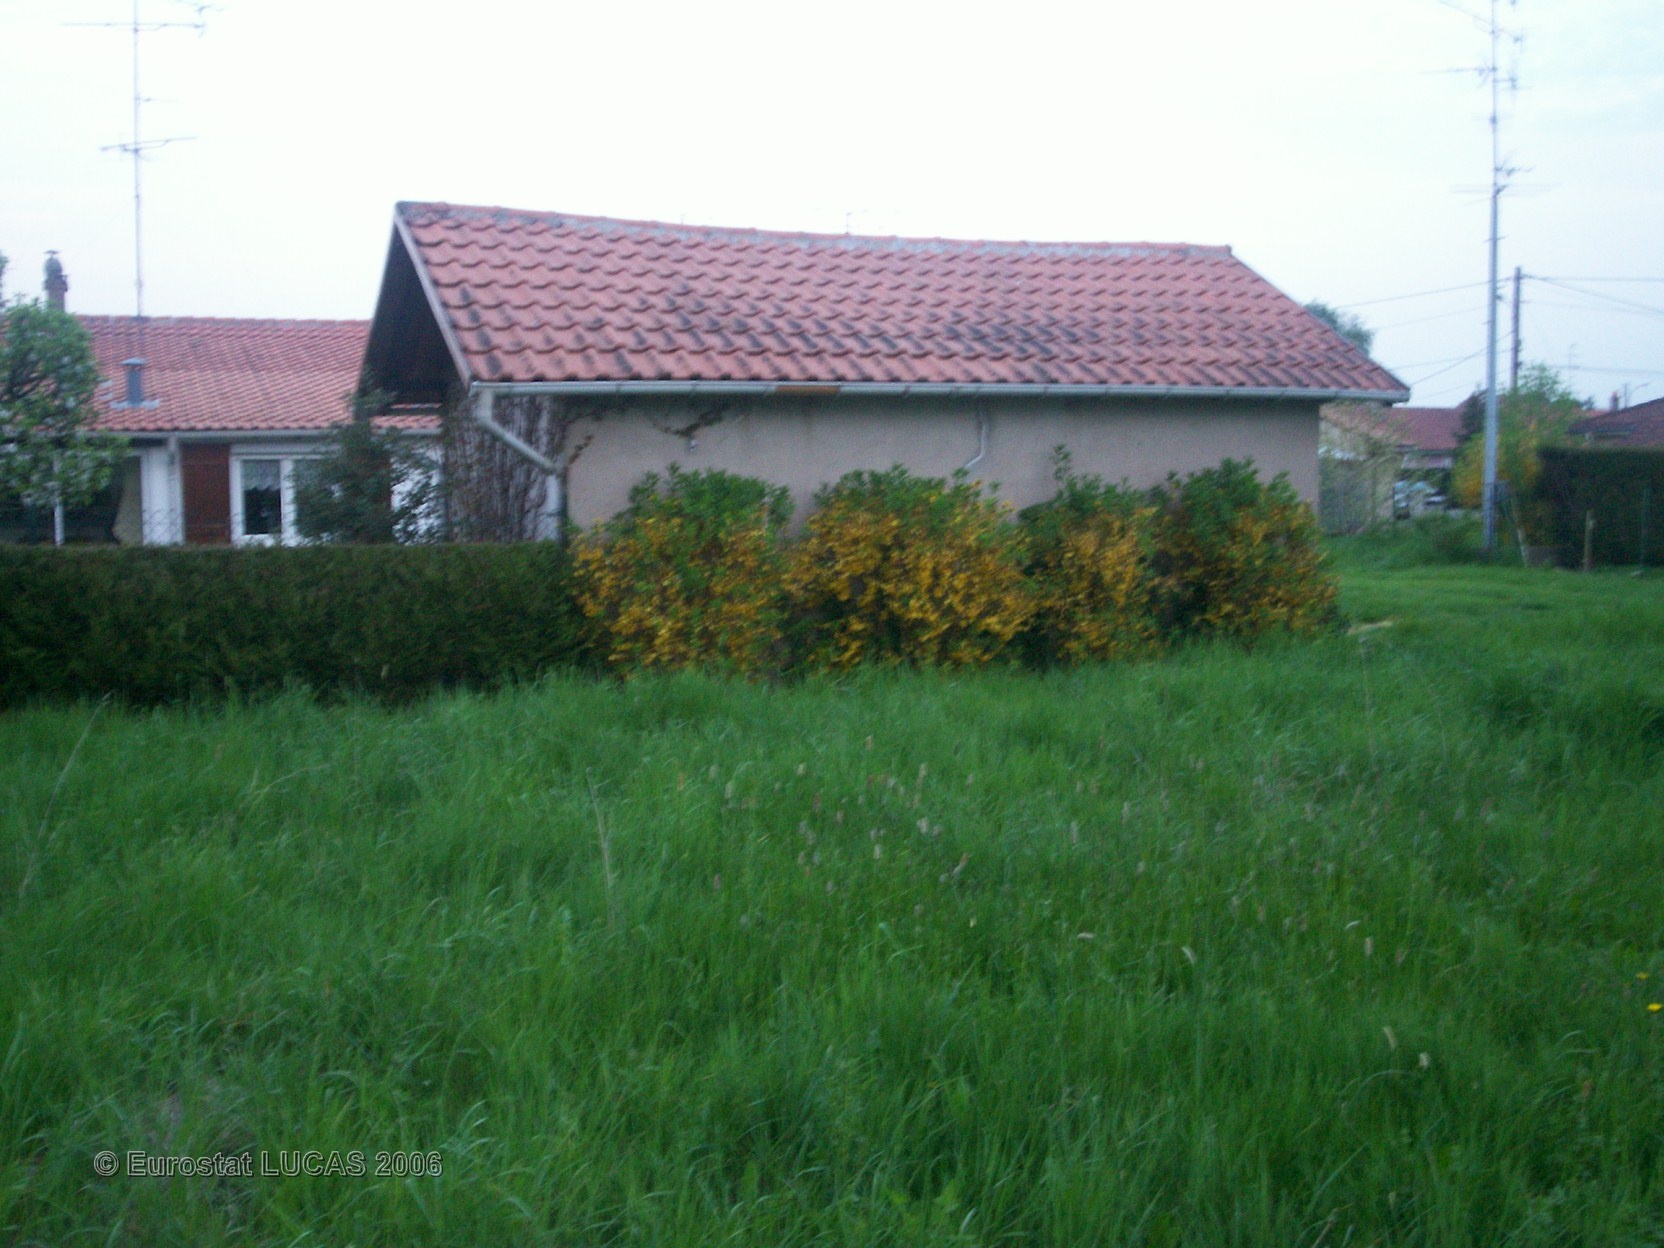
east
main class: Grassland
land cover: Grassland without tree/shrub cover
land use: Agriculture (excluding fallow land and kitchen gardens)
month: May
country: FR
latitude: 48.7430
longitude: 7.0768
